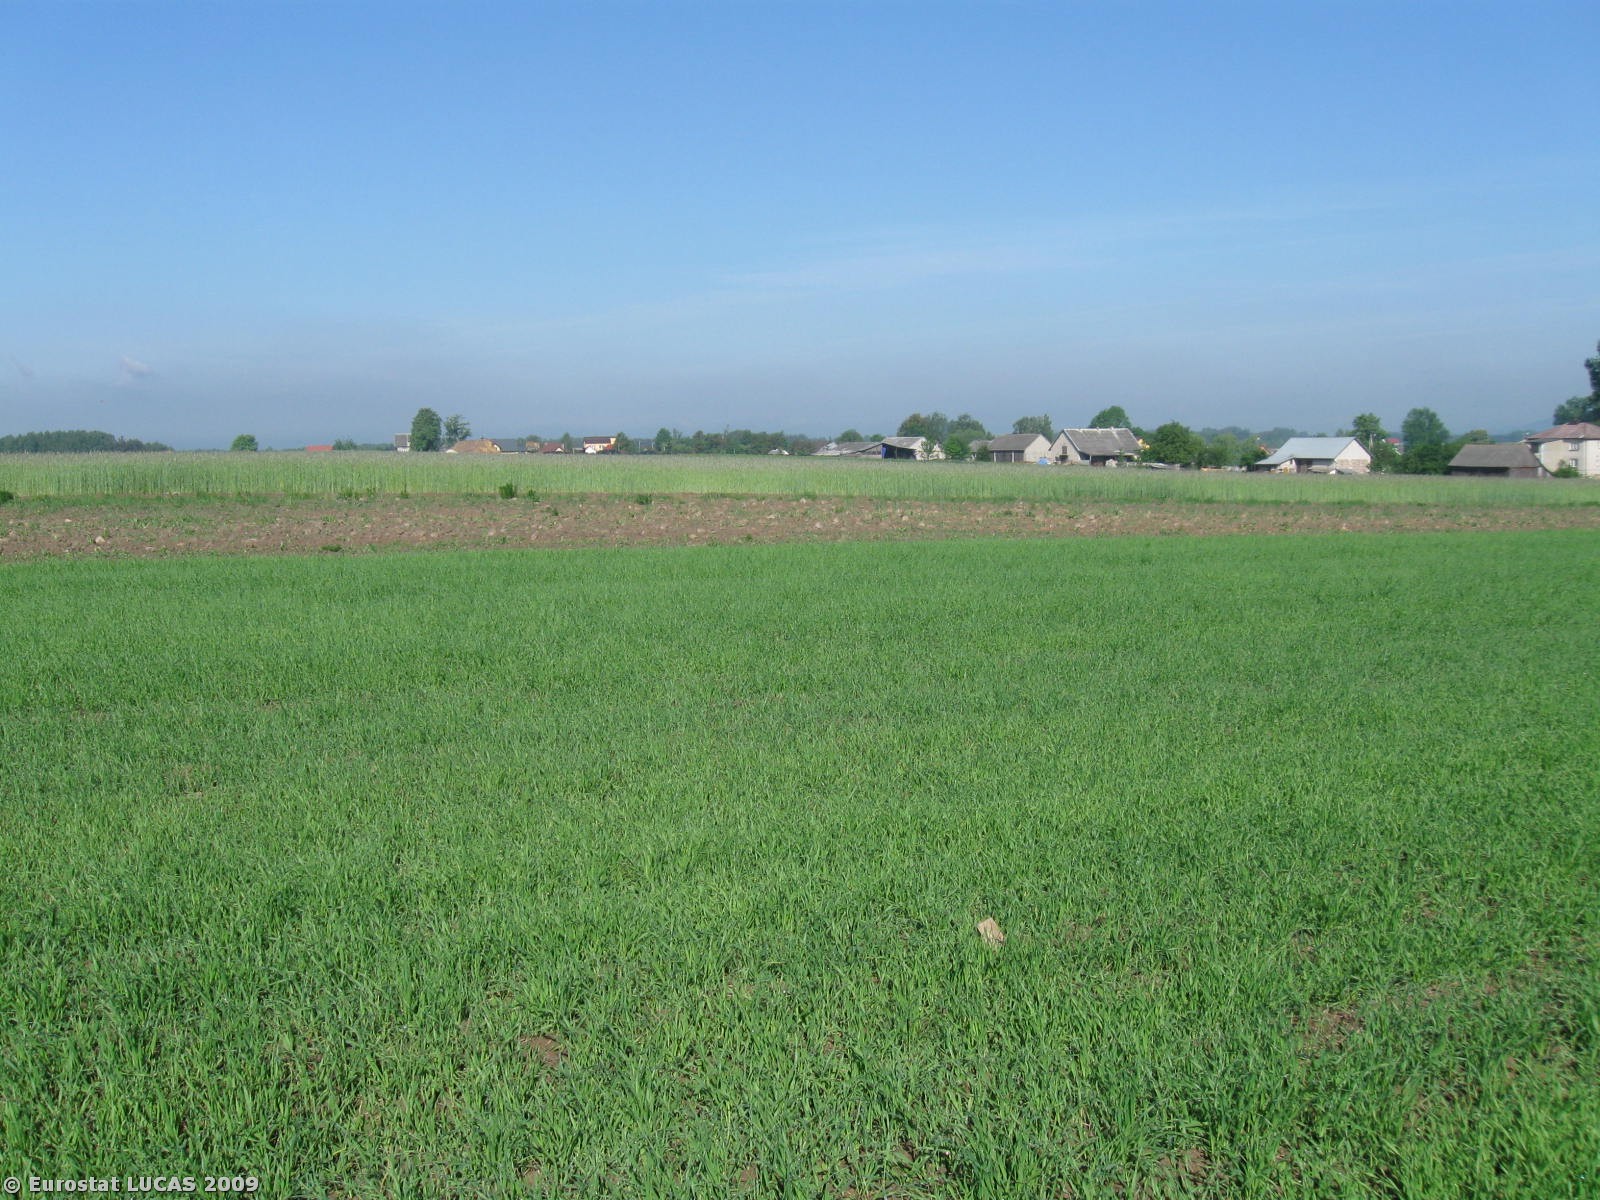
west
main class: Cropland
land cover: Barley
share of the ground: > 75 %
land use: Agriculture (excluding fallow land and kitchen gardens)
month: May
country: PL
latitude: 50.9189
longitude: 20.4359
